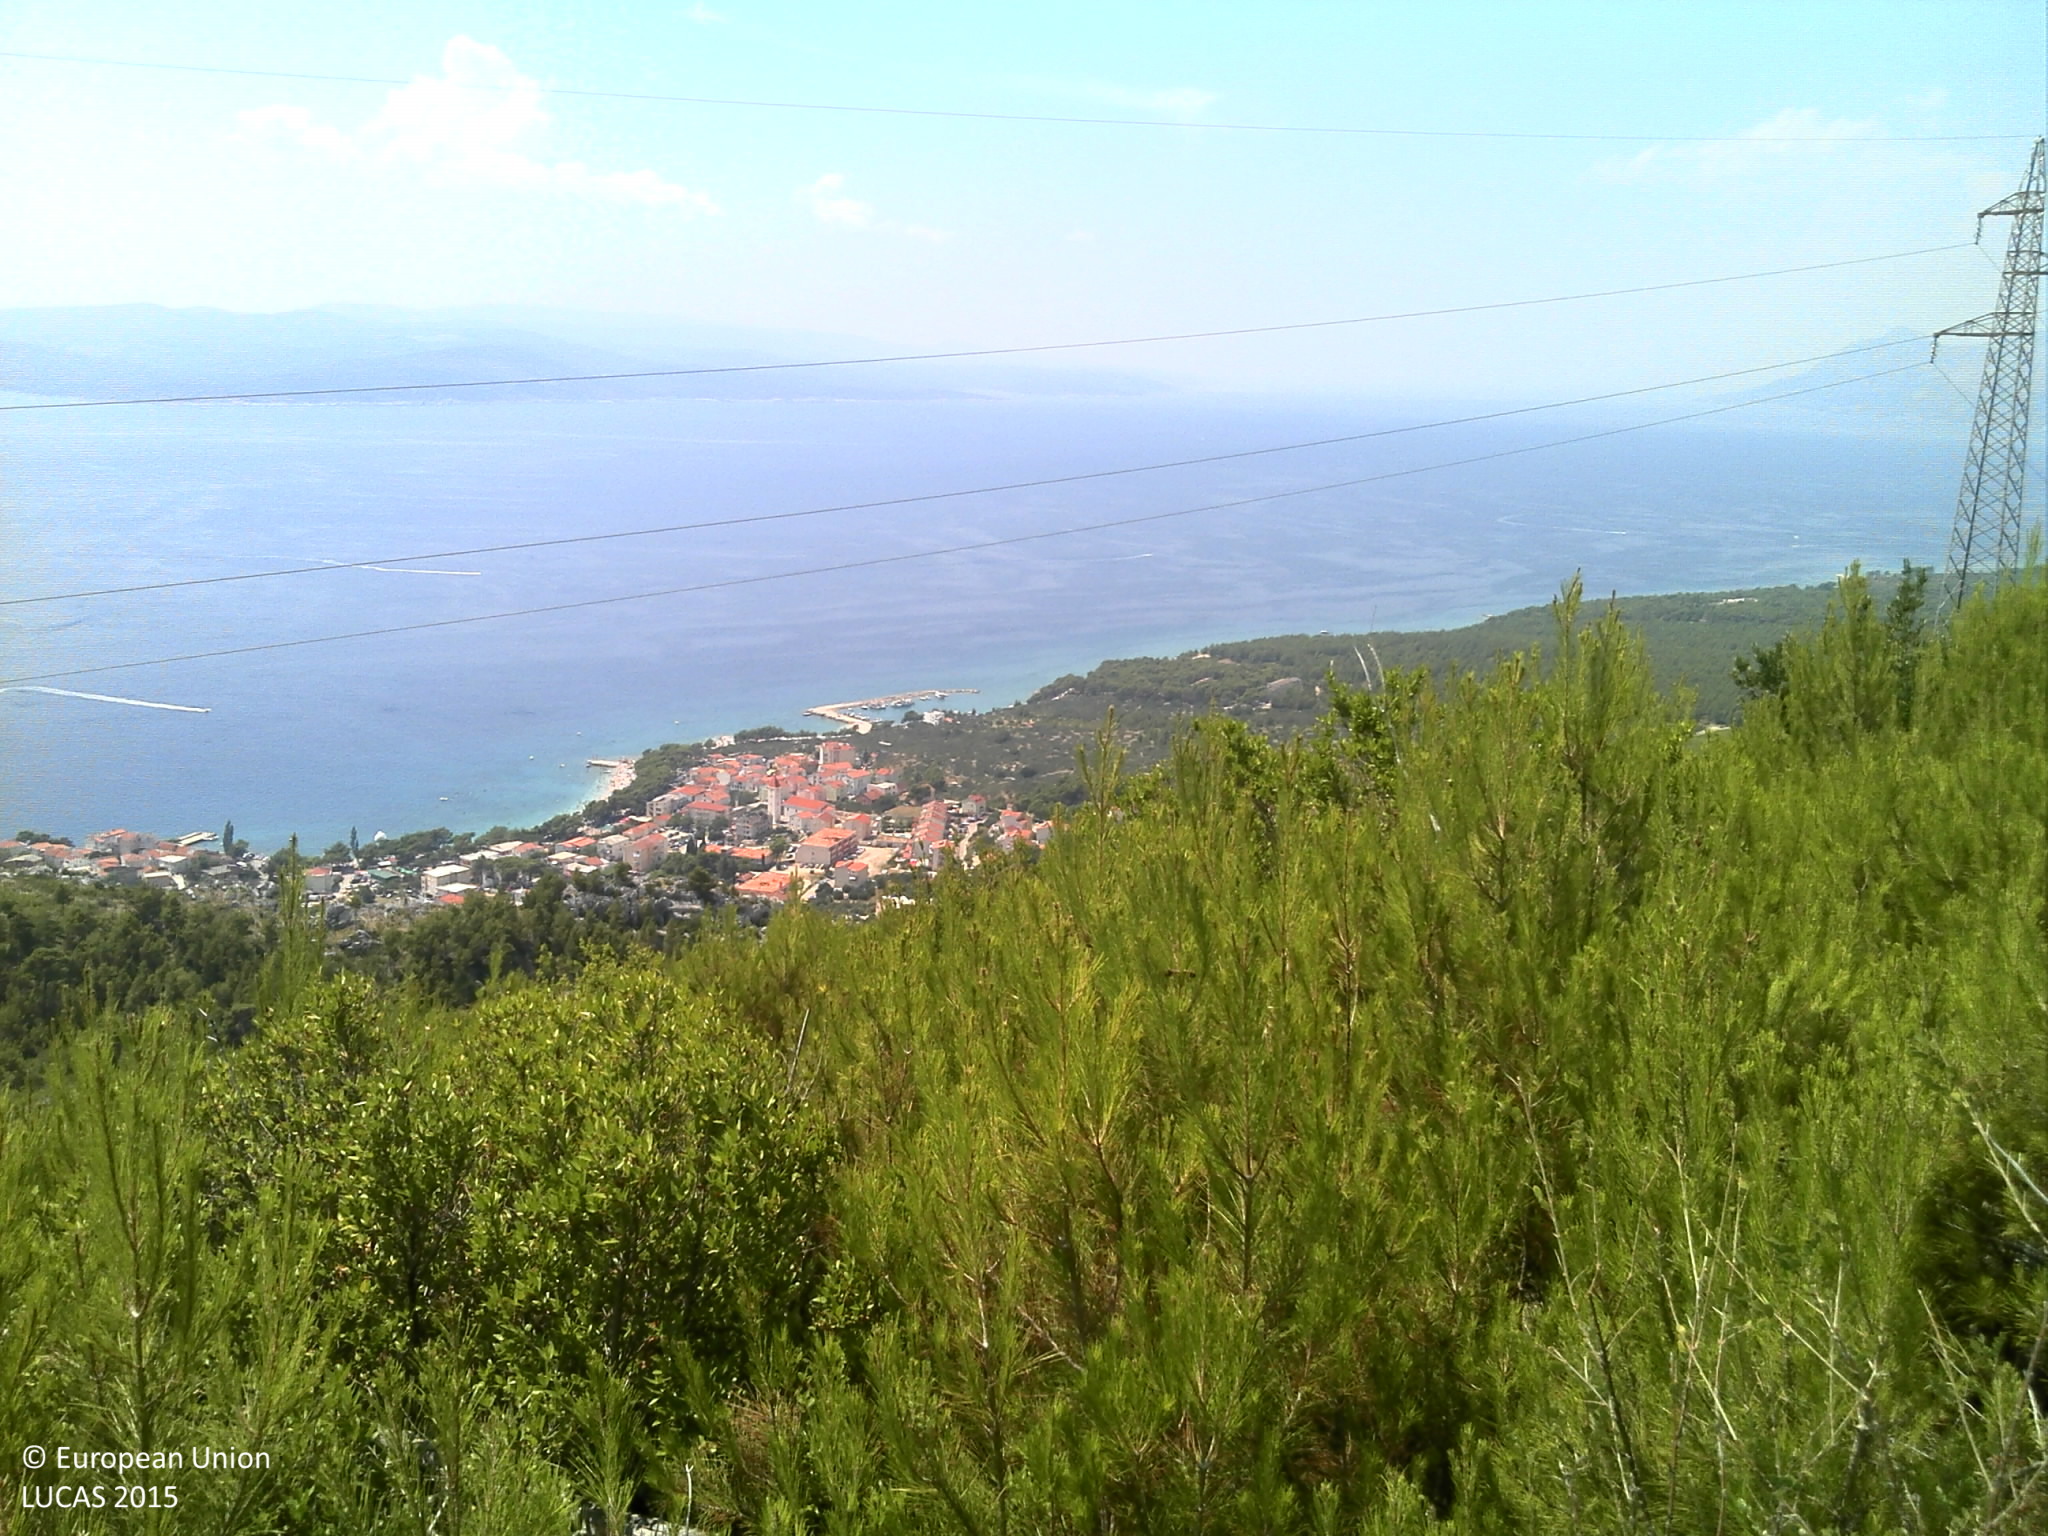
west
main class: Shrubland
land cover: Shrubland with sparse tree cover
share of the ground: > 75 %
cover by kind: shrubs 65 %, herbaceous plants 20 %, coniferous forest trees 5 %, consolidated bare surface 5 %, unconsolidated bare surface 5 %
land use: Semi-natural and natural areas not in use
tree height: < 5 m
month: August
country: HR
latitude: 43.3366
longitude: 16.9845
